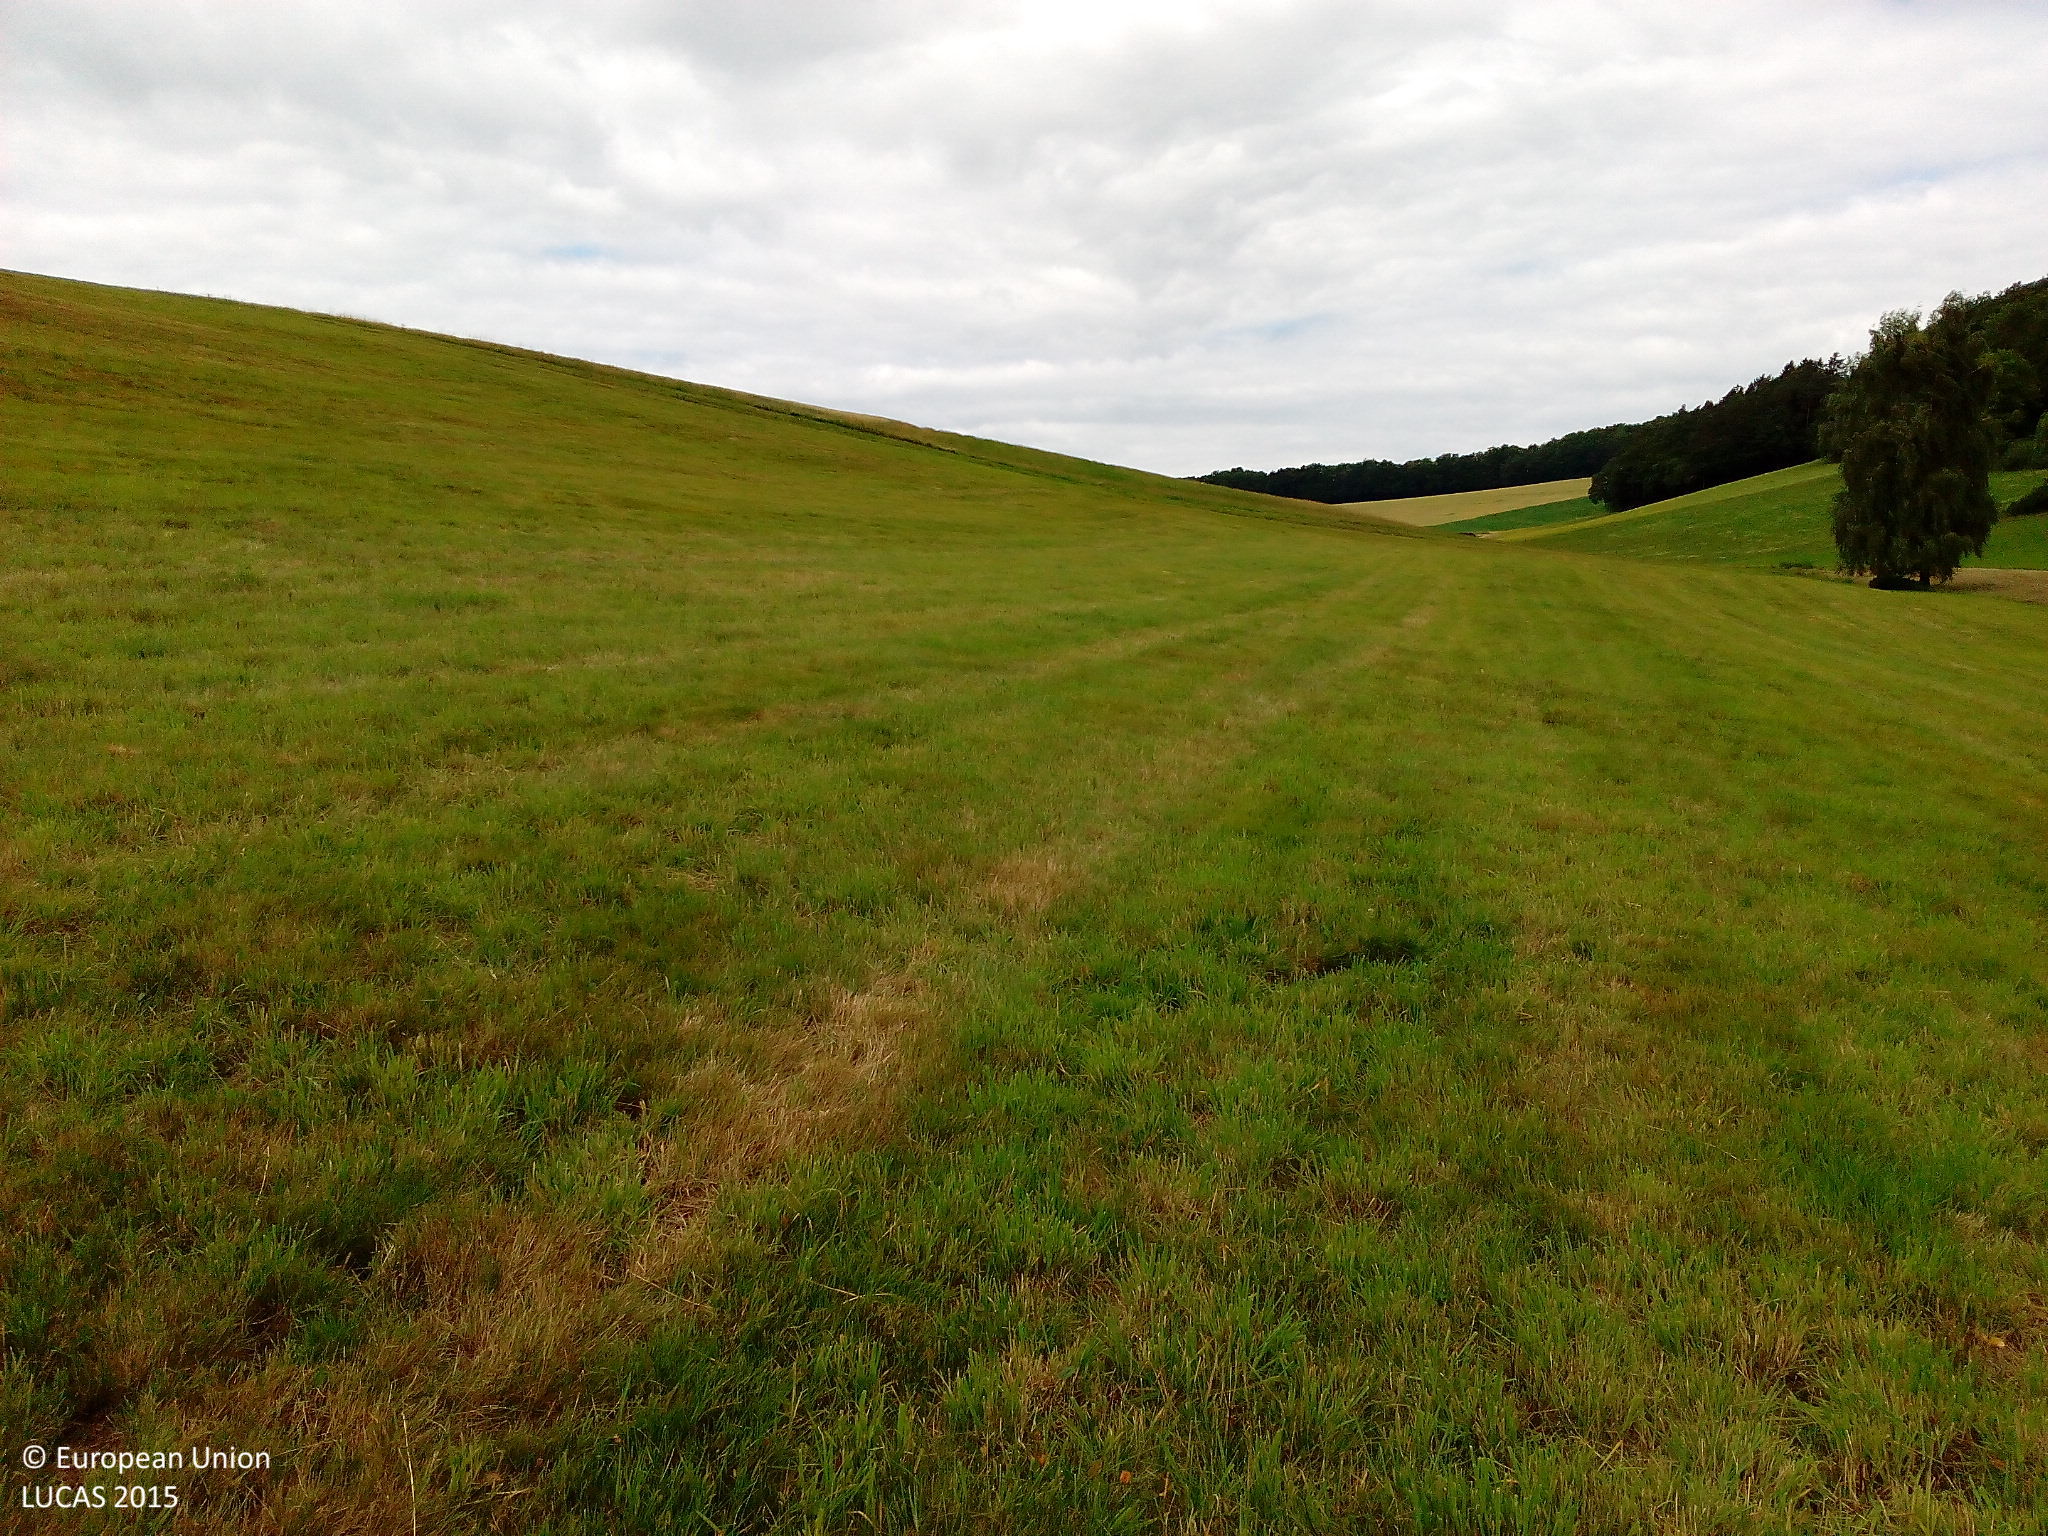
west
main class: Grassland
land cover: Grassland without tree/shrub cover
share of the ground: > 75 %
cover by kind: herbaceous plants 100 %
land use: Agriculture (excluding fallow land and kitchen gardens)
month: July
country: DE
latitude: 51.1011
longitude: 9.8715
